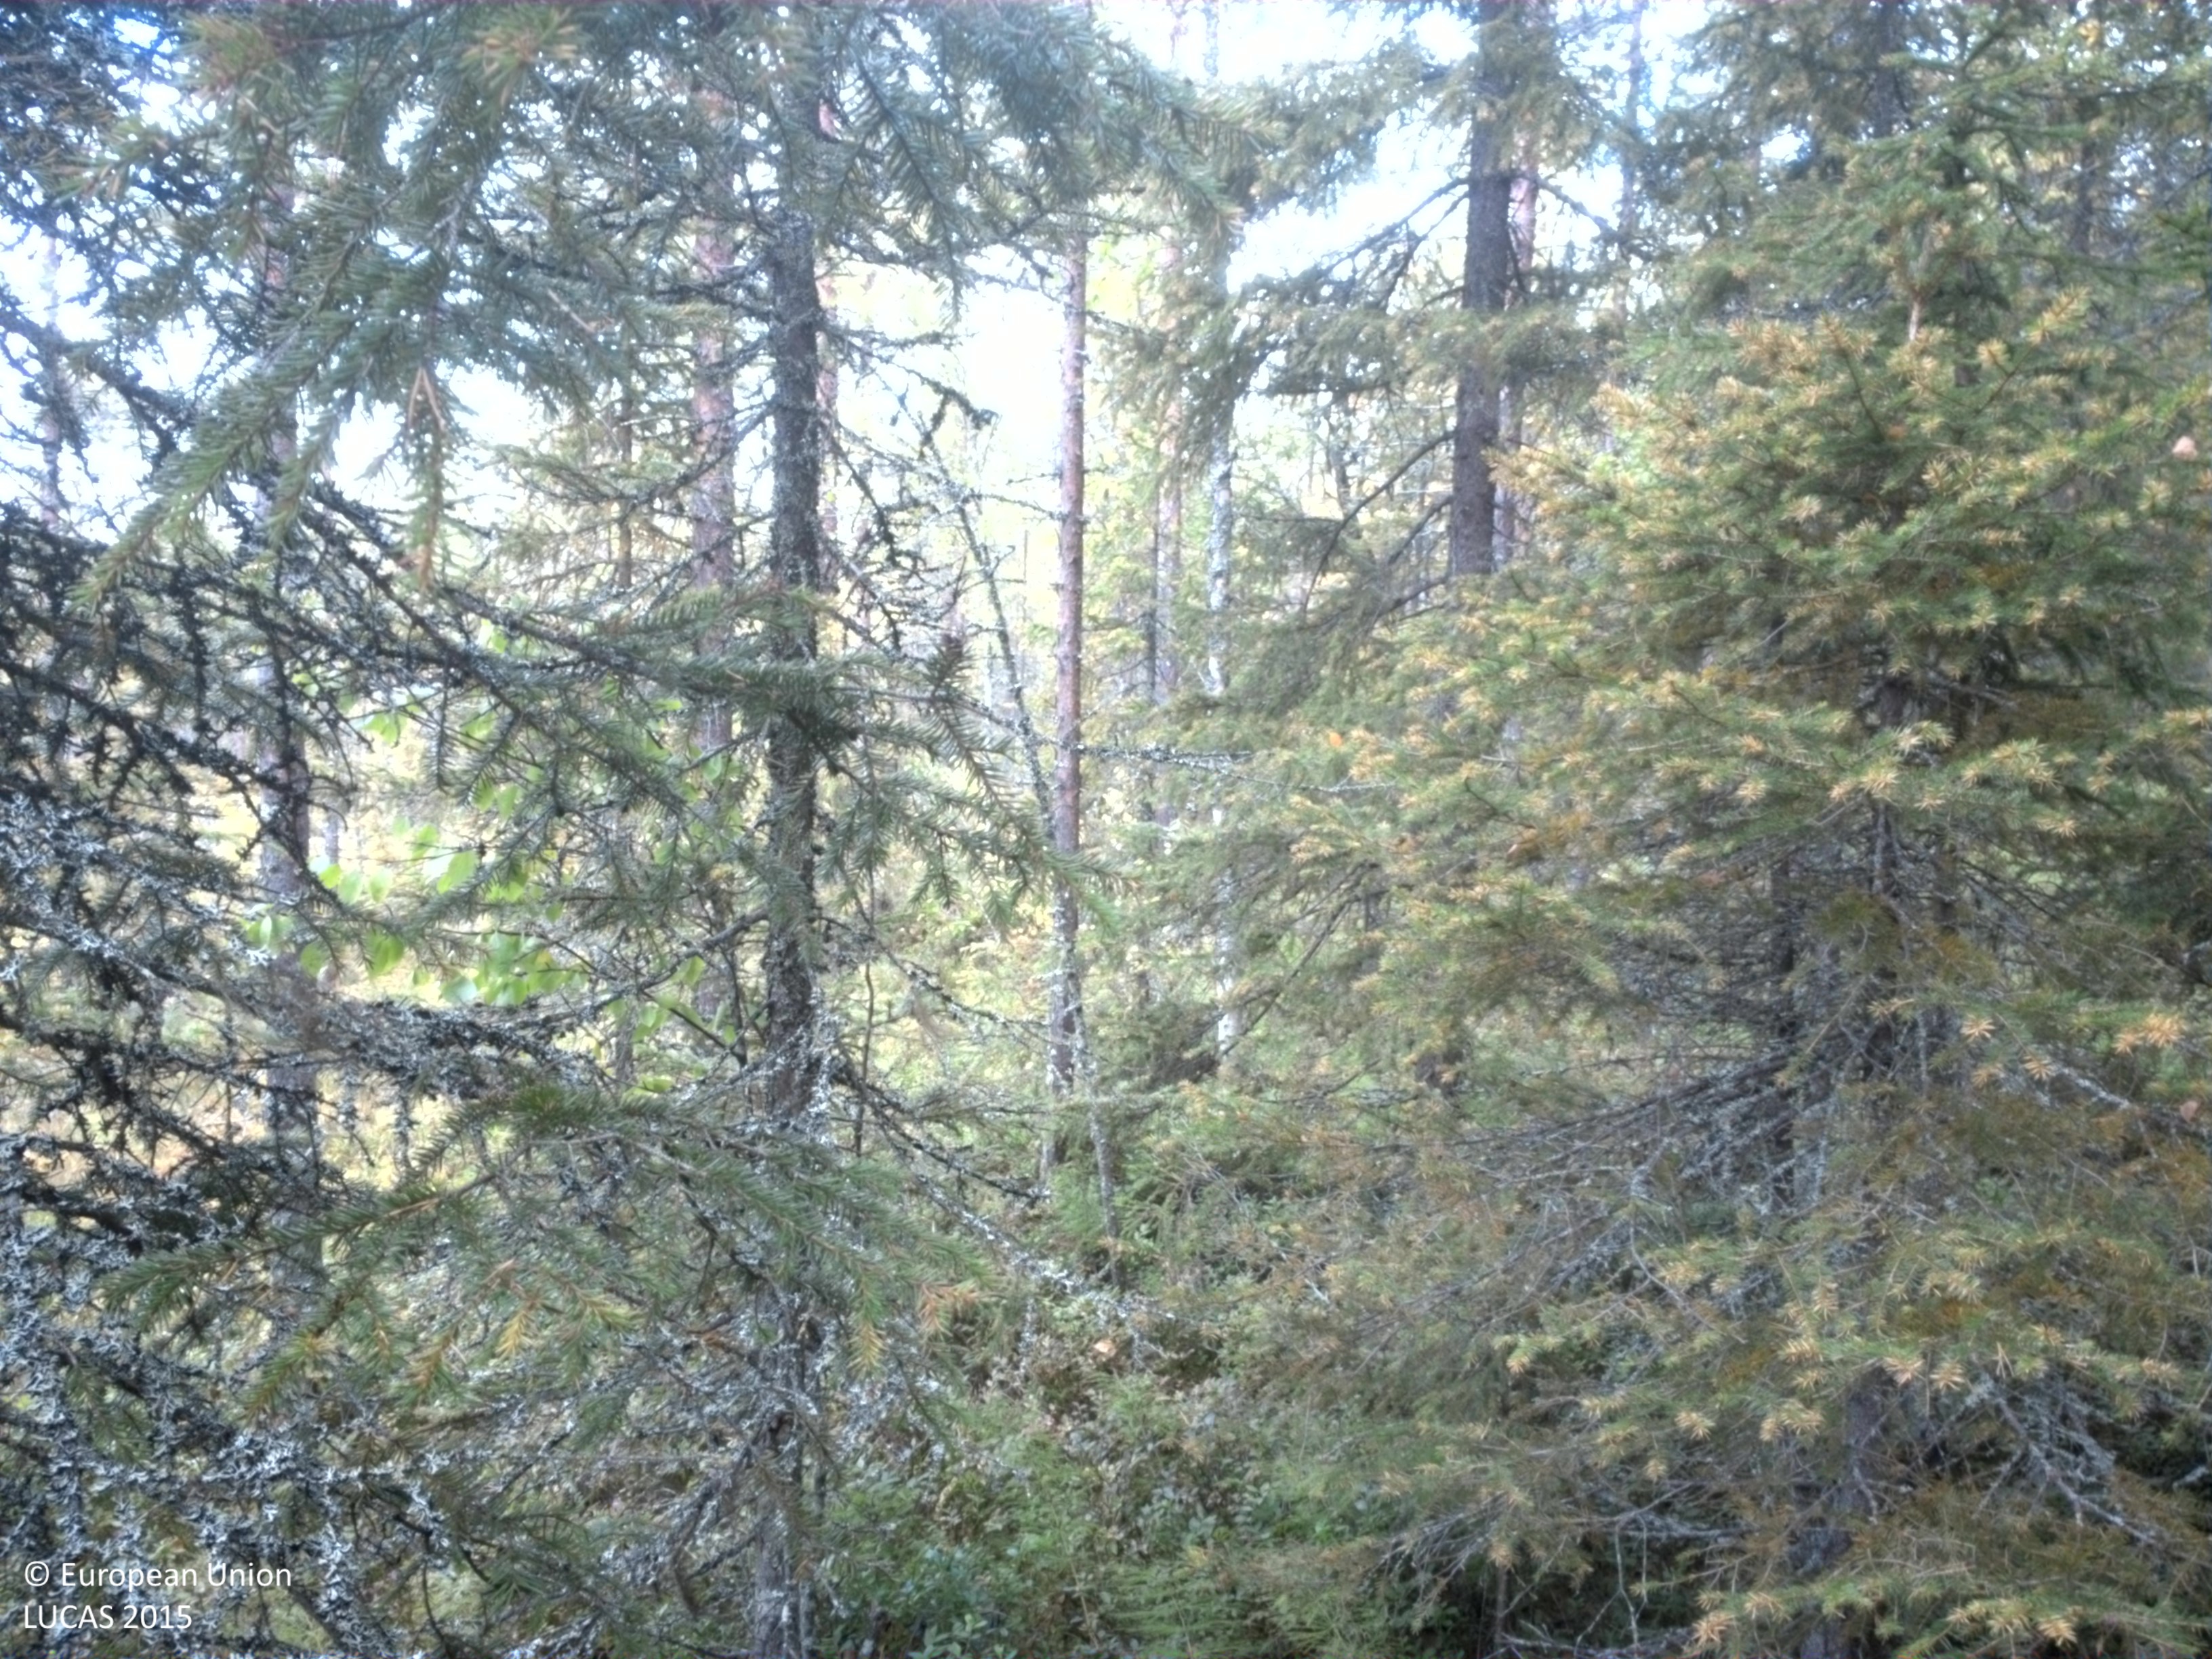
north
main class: Woodland
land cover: Spruce dominated mixed woodland
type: boreal forest
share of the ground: 50 - 75 %
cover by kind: coniferous forest trees 45 %, shrubs 35 %, broadleaved forest trees 15 %, lichens and mosses 5 %
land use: Forestry
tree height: > 5 m
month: September
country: SE
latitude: 64.4790
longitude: 19.7710
